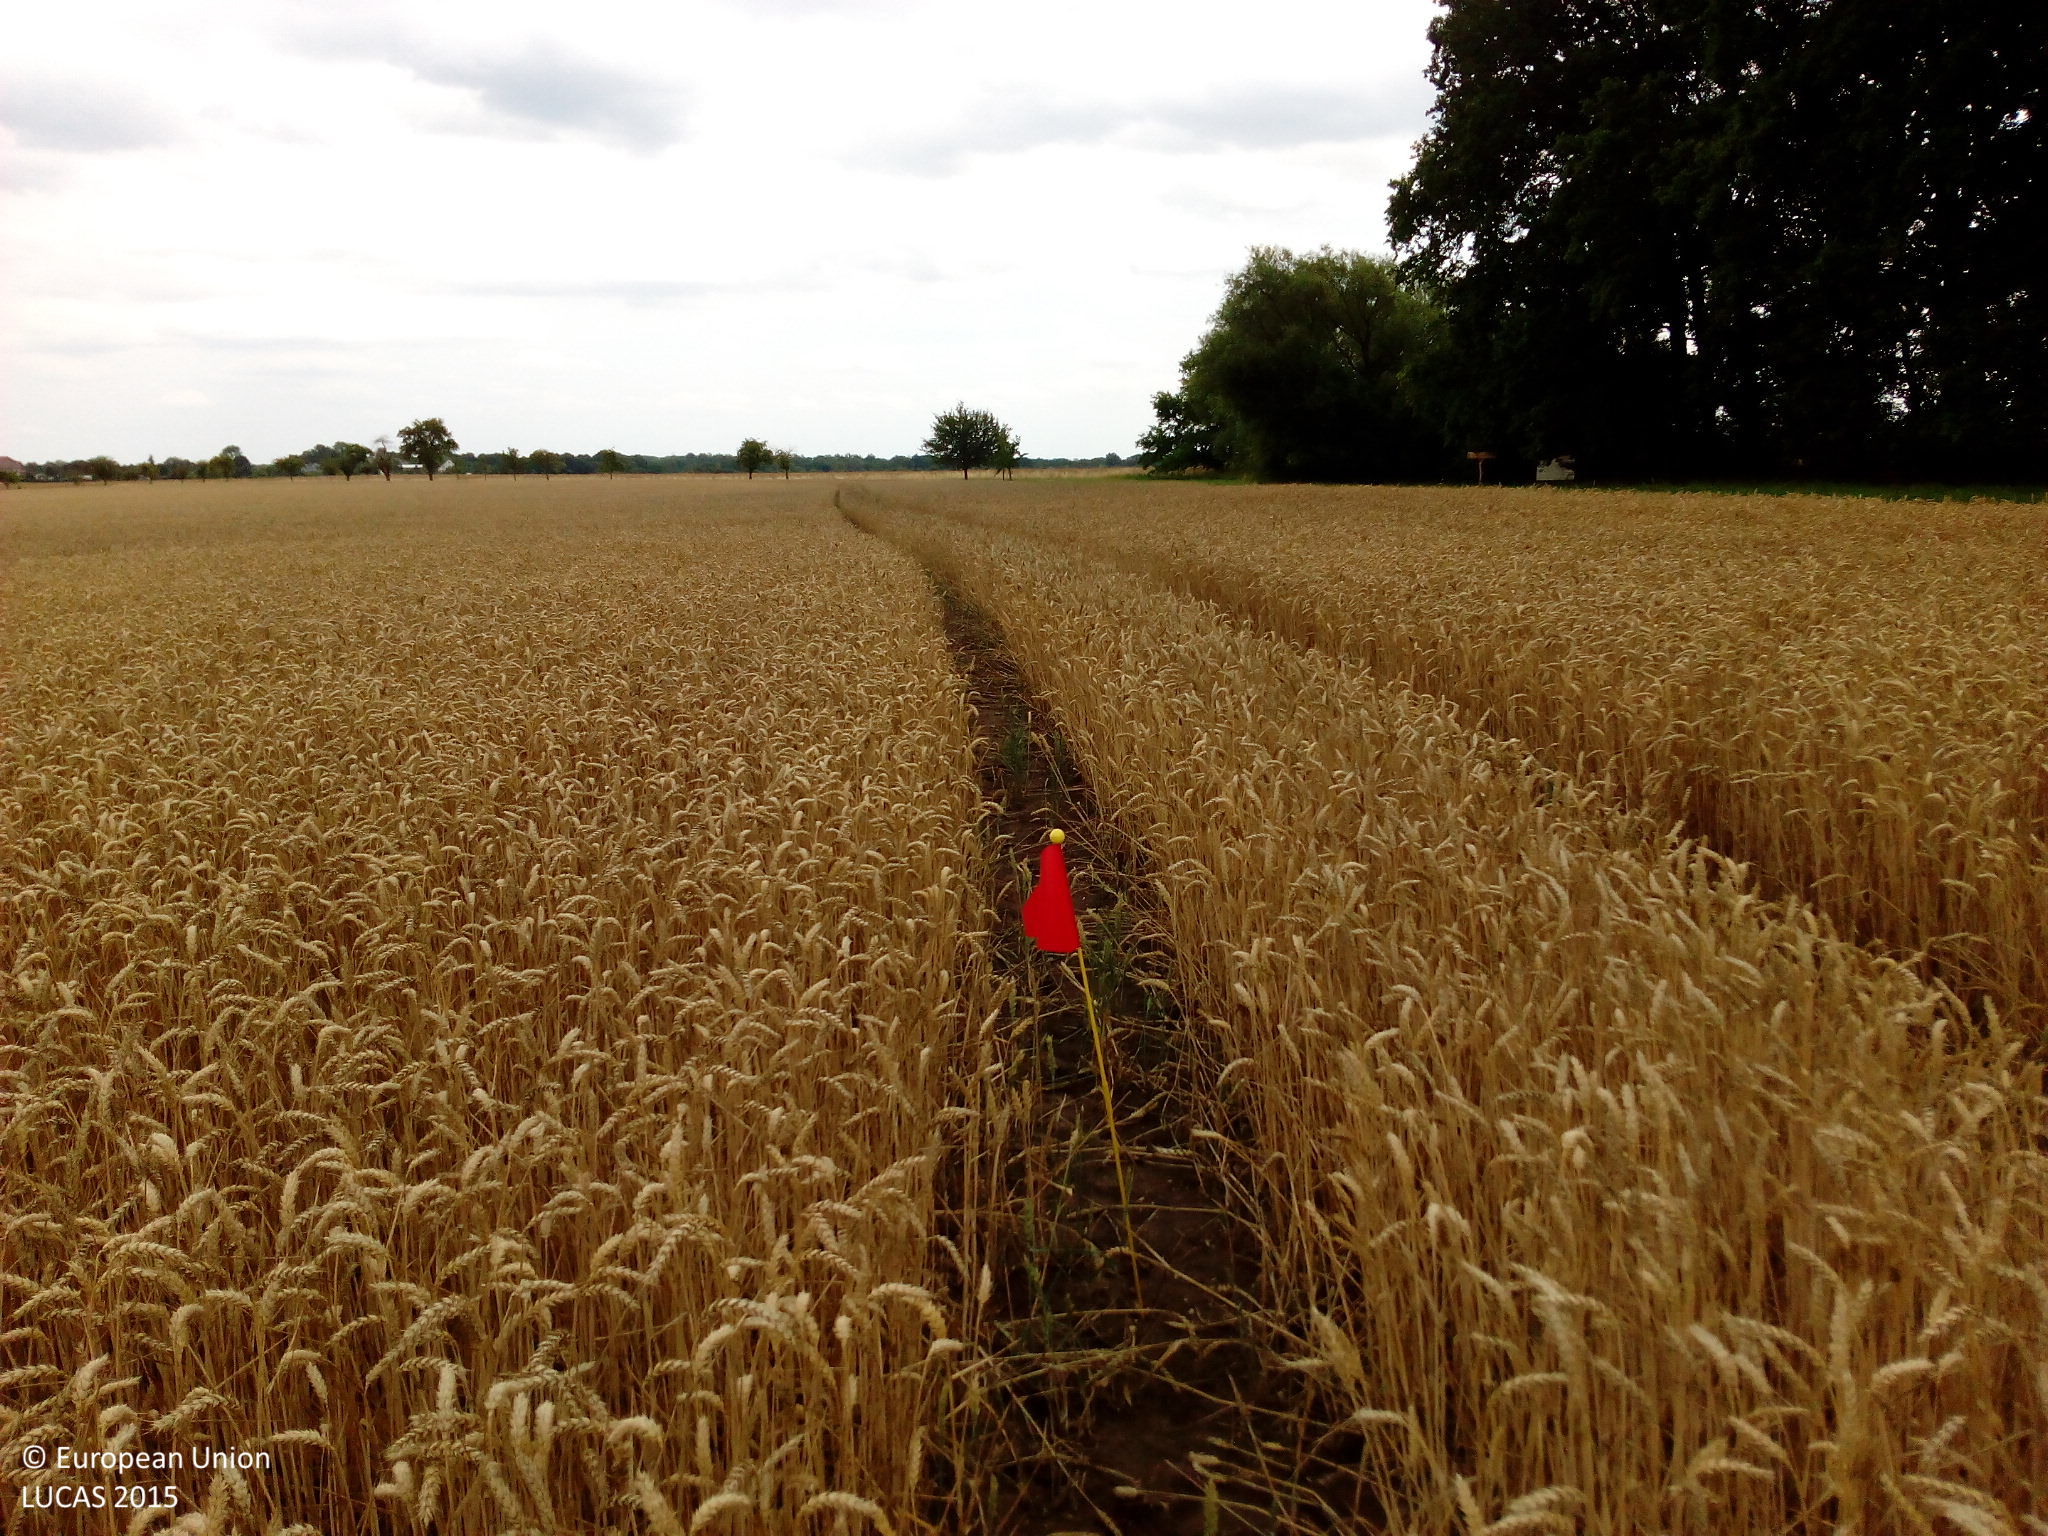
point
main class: Cropland
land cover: Common wheat
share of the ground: > 75 %
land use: Agriculture (excluding fallow land and kitchen gardens)
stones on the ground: < 10 %
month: July
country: DE
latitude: 52.0596
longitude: 11.7060
